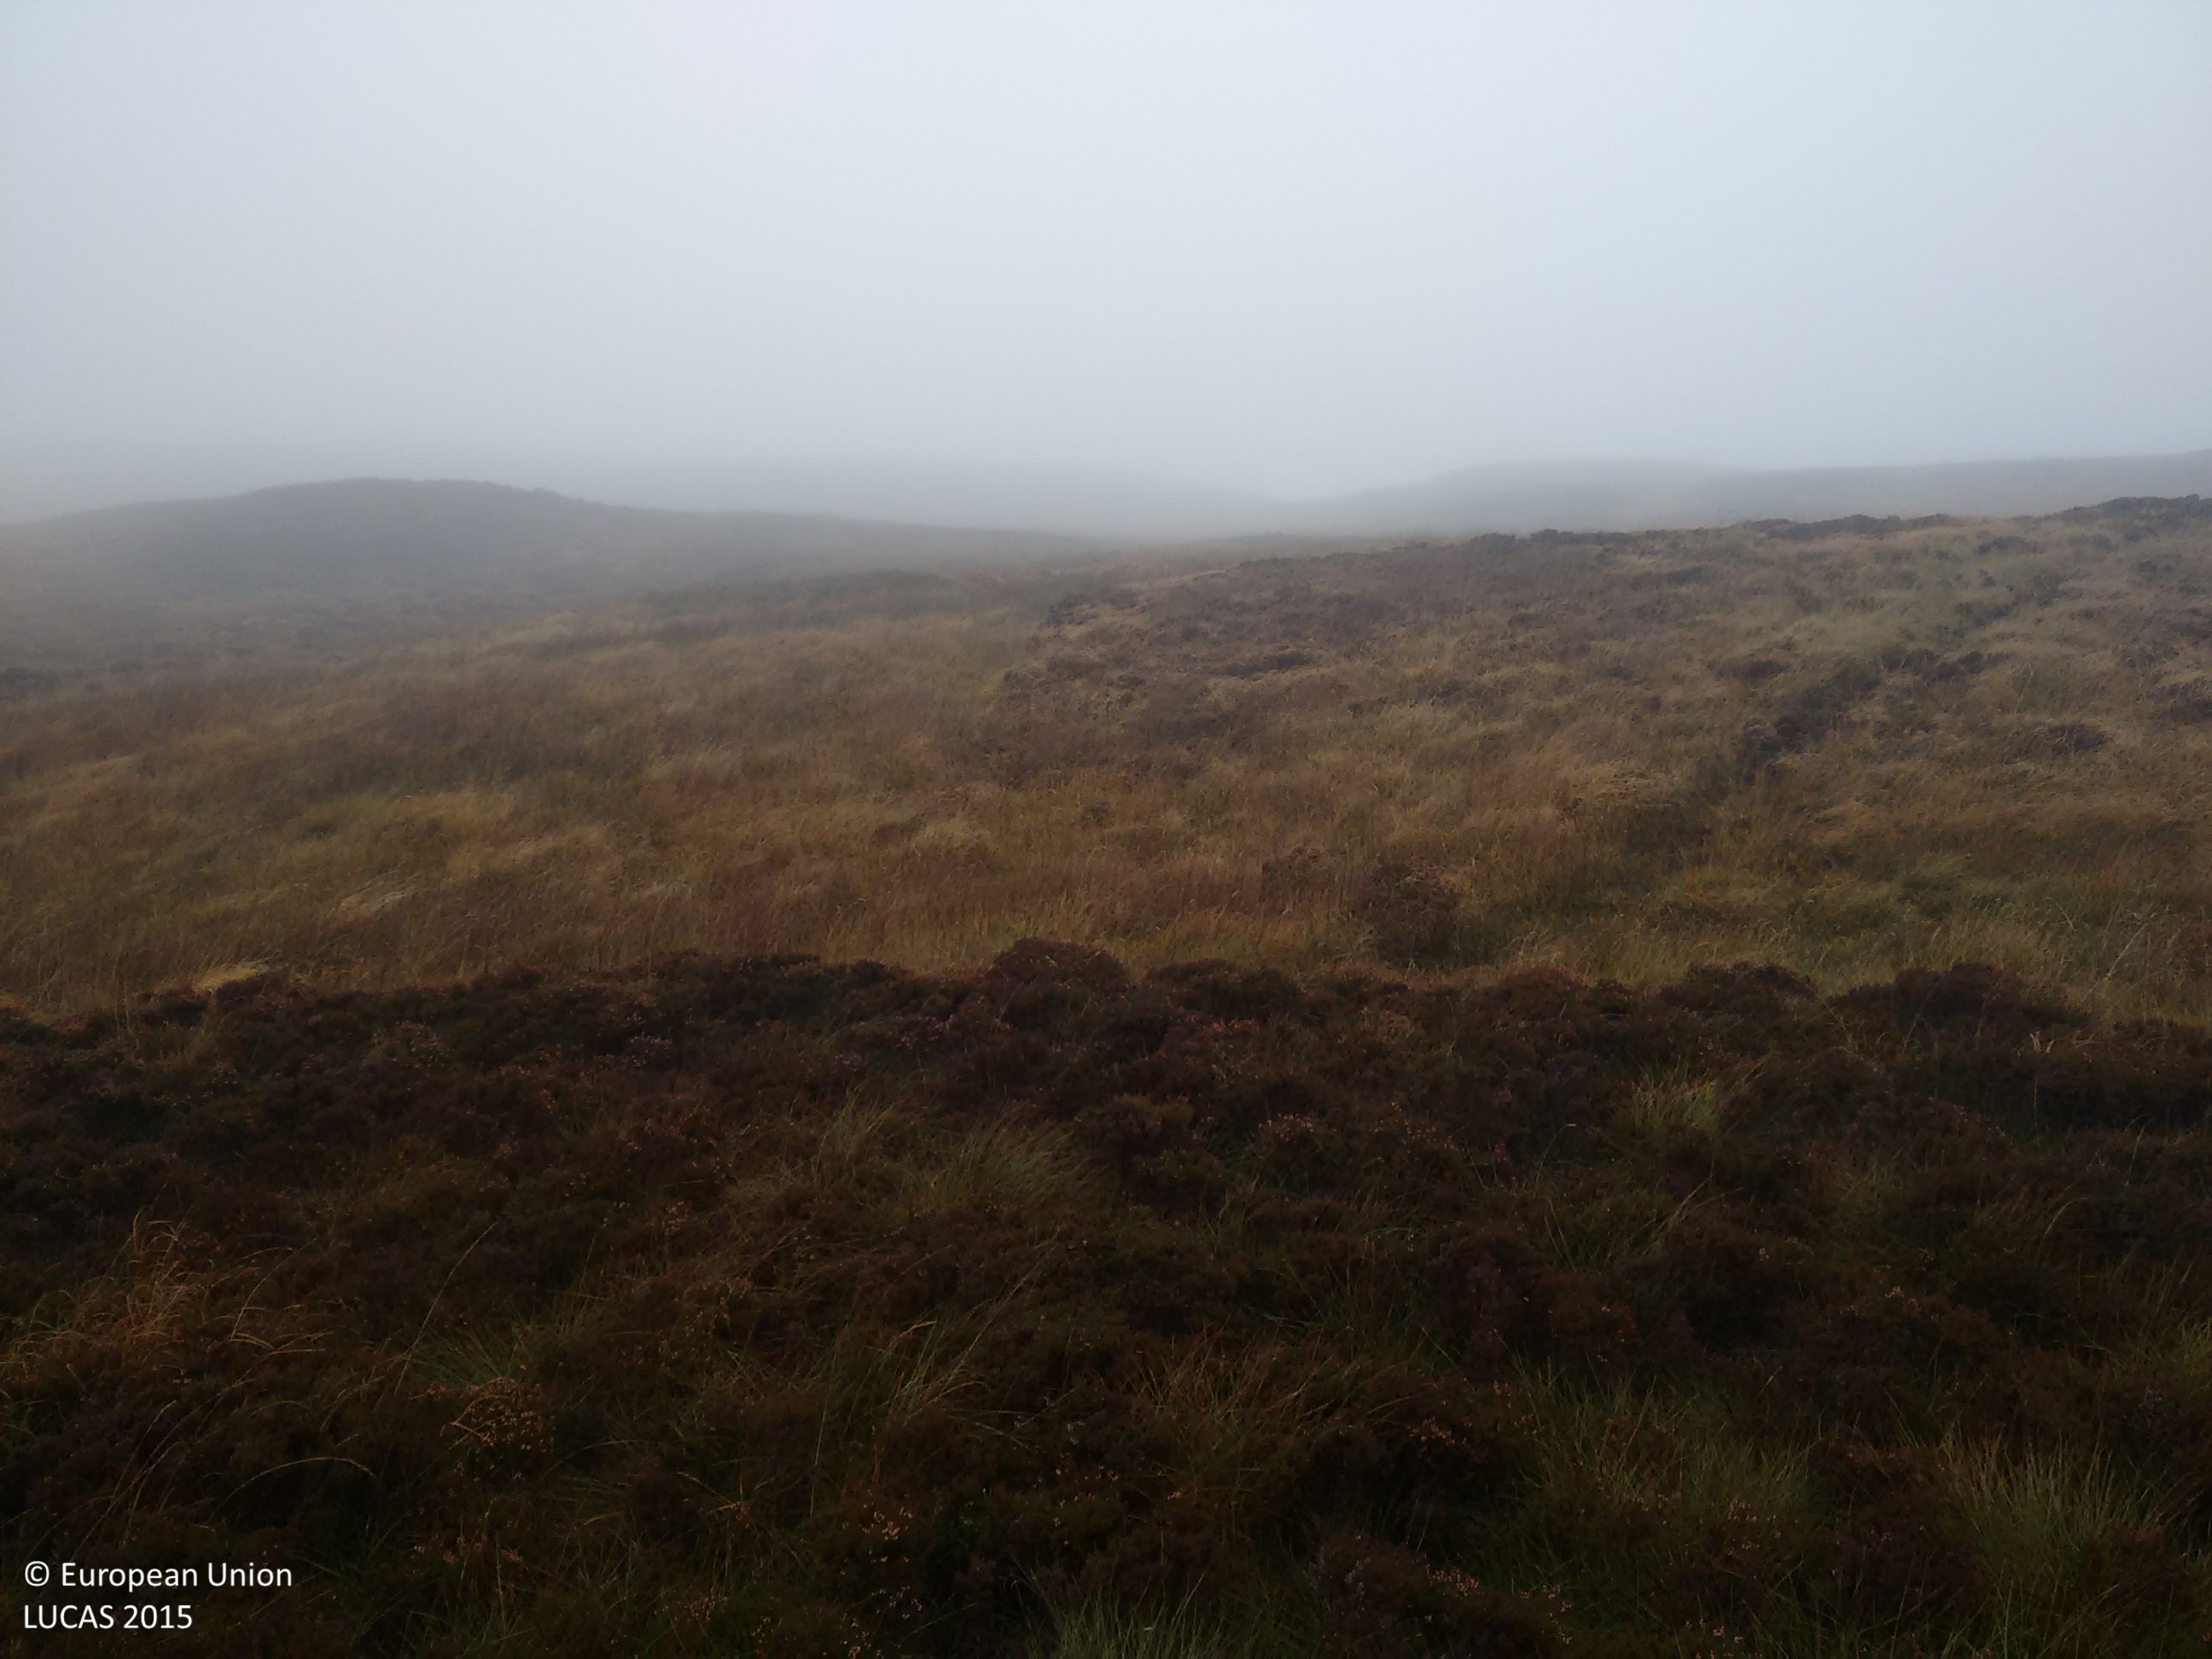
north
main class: Shrubland
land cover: Shrubland without tree cover
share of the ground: > 75 %
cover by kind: shrubs 90 %, herbaceous plants 5 %, lichens and mosses 5 %
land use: Agriculture (excluding fallow land and kitchen gardens)
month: October
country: GB
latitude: 55.6140
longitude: -6.2922
